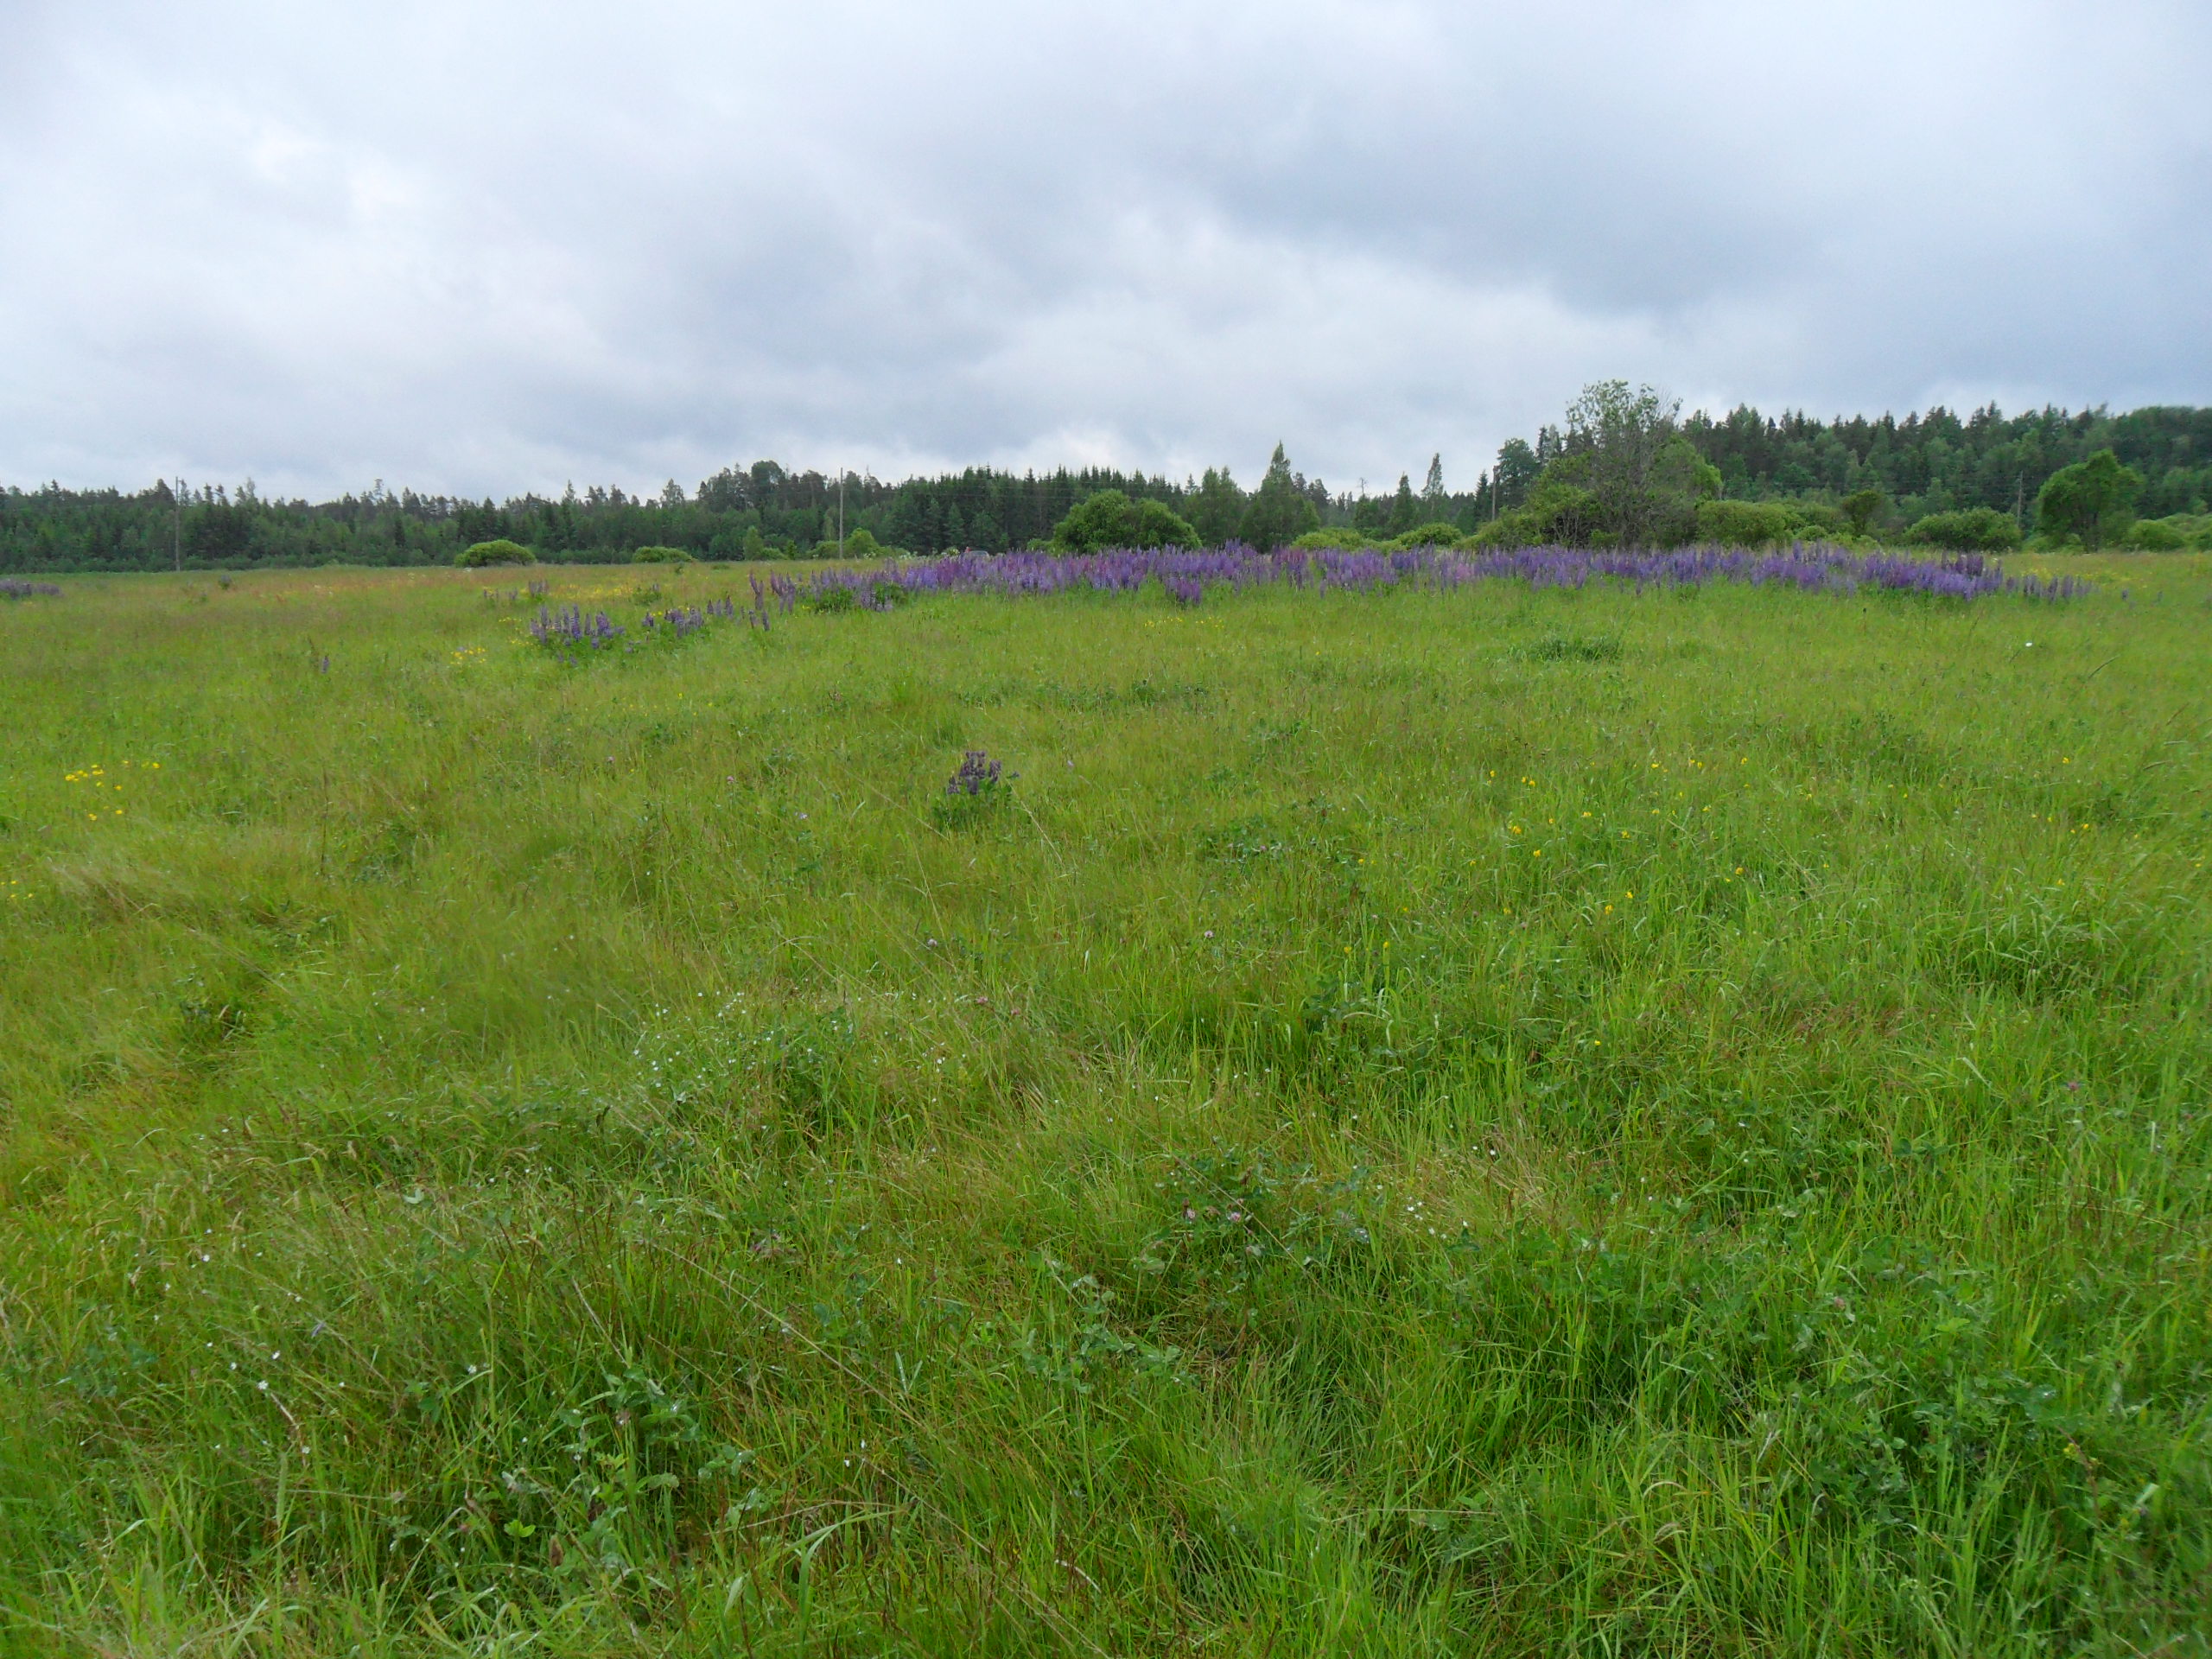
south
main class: Grassland
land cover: Grassland without tree/shrub cover
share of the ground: > 75 %
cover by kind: herbaceous plants 100 %
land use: Agriculture (excluding fallow land and kitchen gardens)
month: June
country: LV
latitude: 57.2839
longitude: 22.1418
